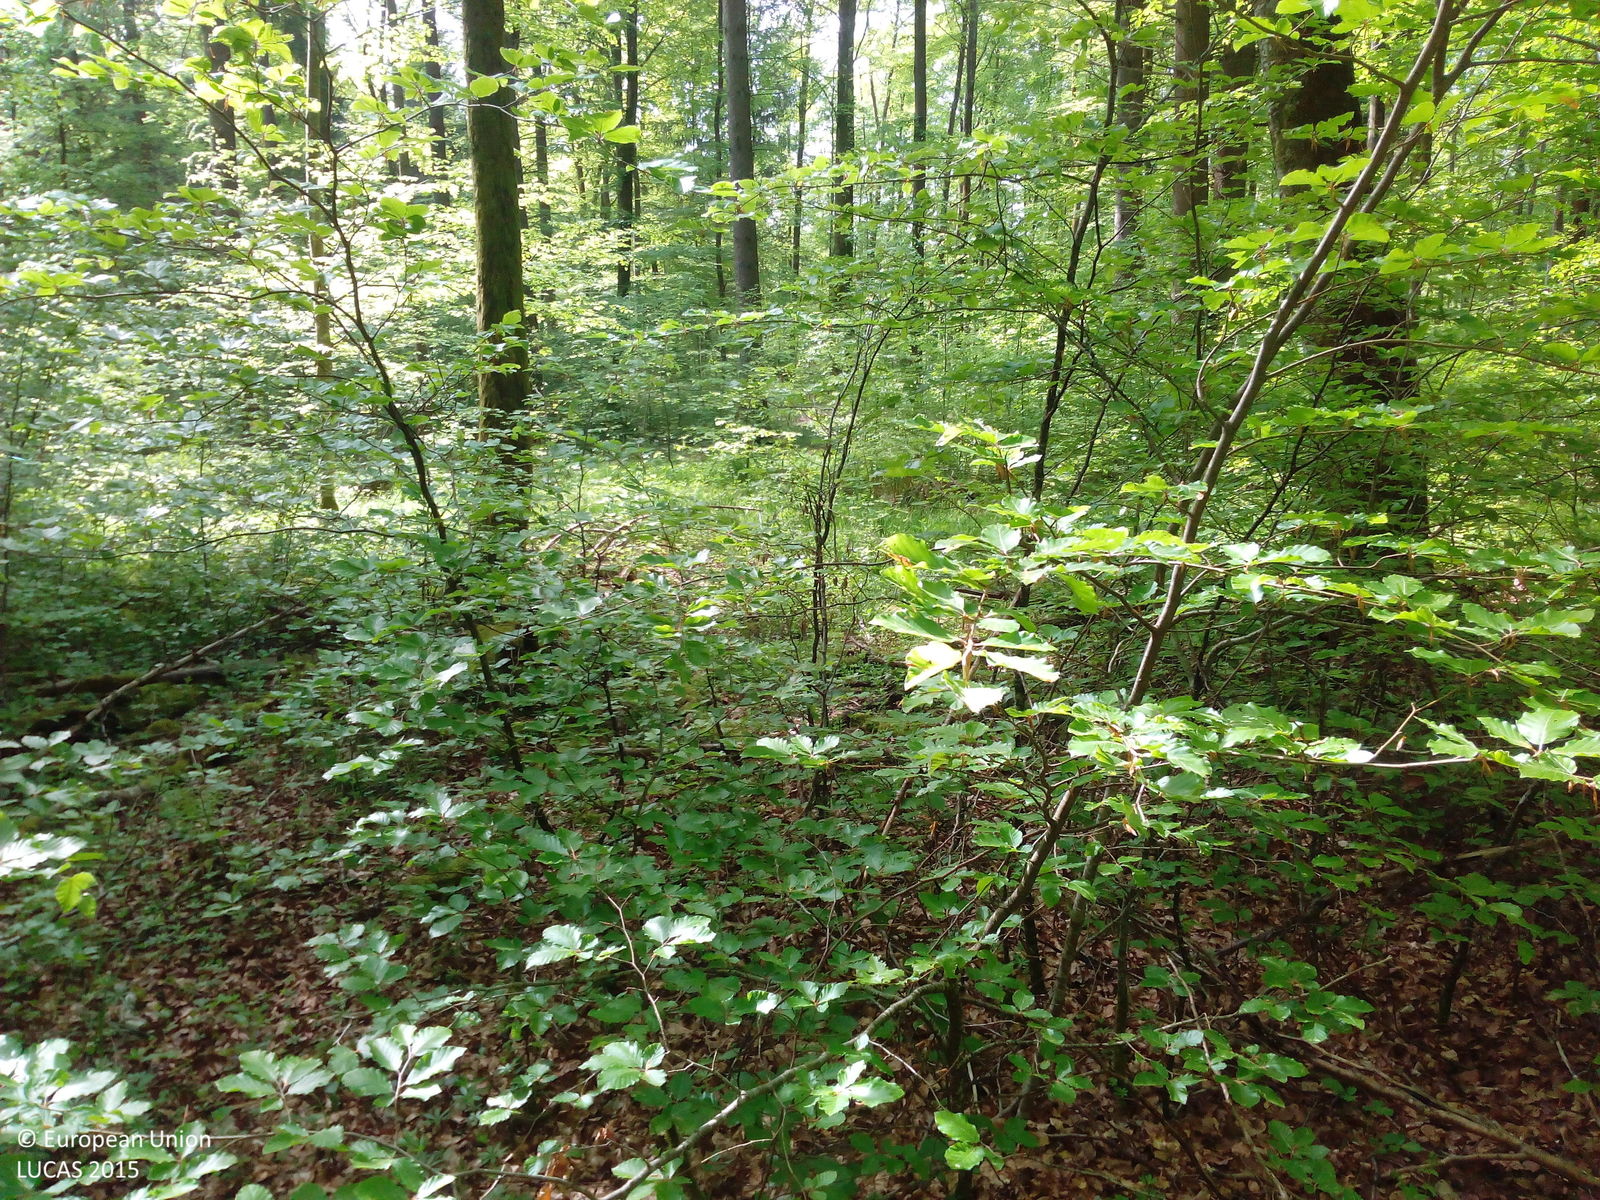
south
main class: Woodland
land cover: Broadleaved woodland
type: beech forest
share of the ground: > 75 %
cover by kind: broadleaved forest trees 75 %, coniferous forest trees 20 %, shrubs 5 %
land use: Forestry
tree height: > 5 m
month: May
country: DE
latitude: 48.0945
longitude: 9.1815
